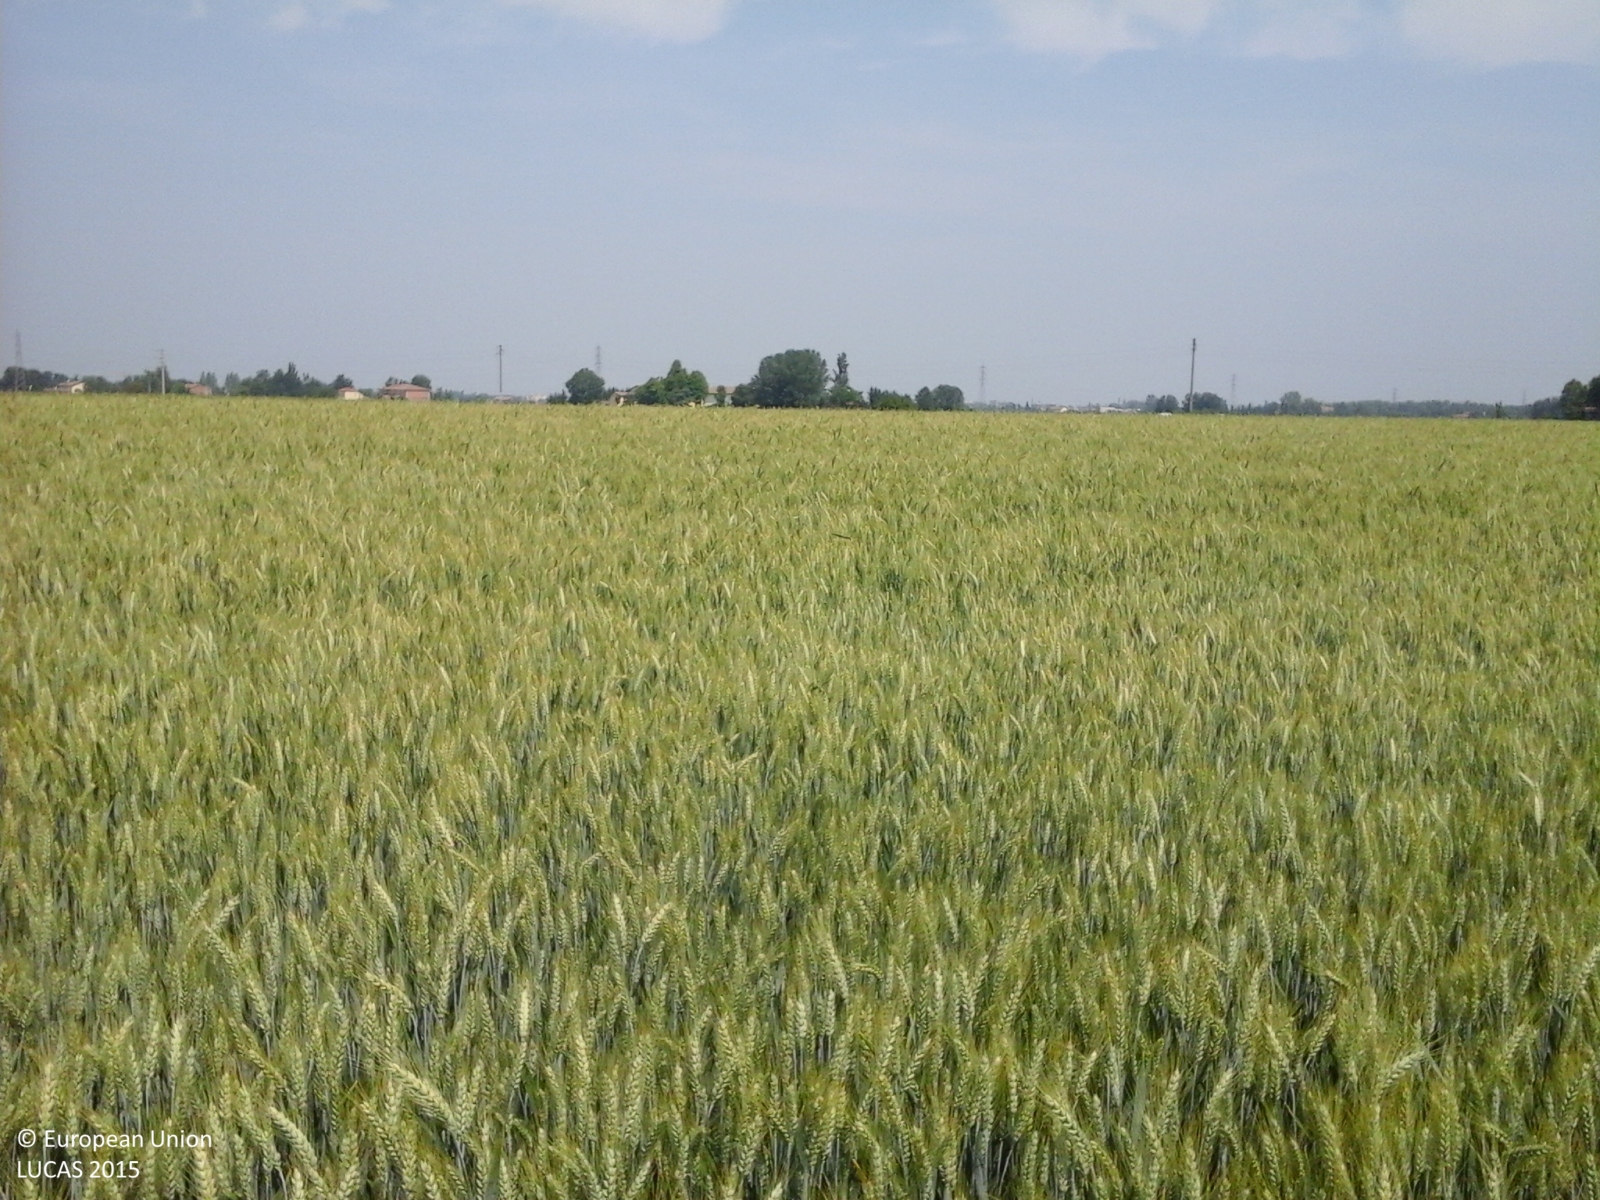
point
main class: Cropland
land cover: Common wheat
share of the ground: > 75 %
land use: Agriculture (excluding fallow land and kitchen gardens)
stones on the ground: < 10 %
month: May
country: IT
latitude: 44.7435
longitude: 10.8948
